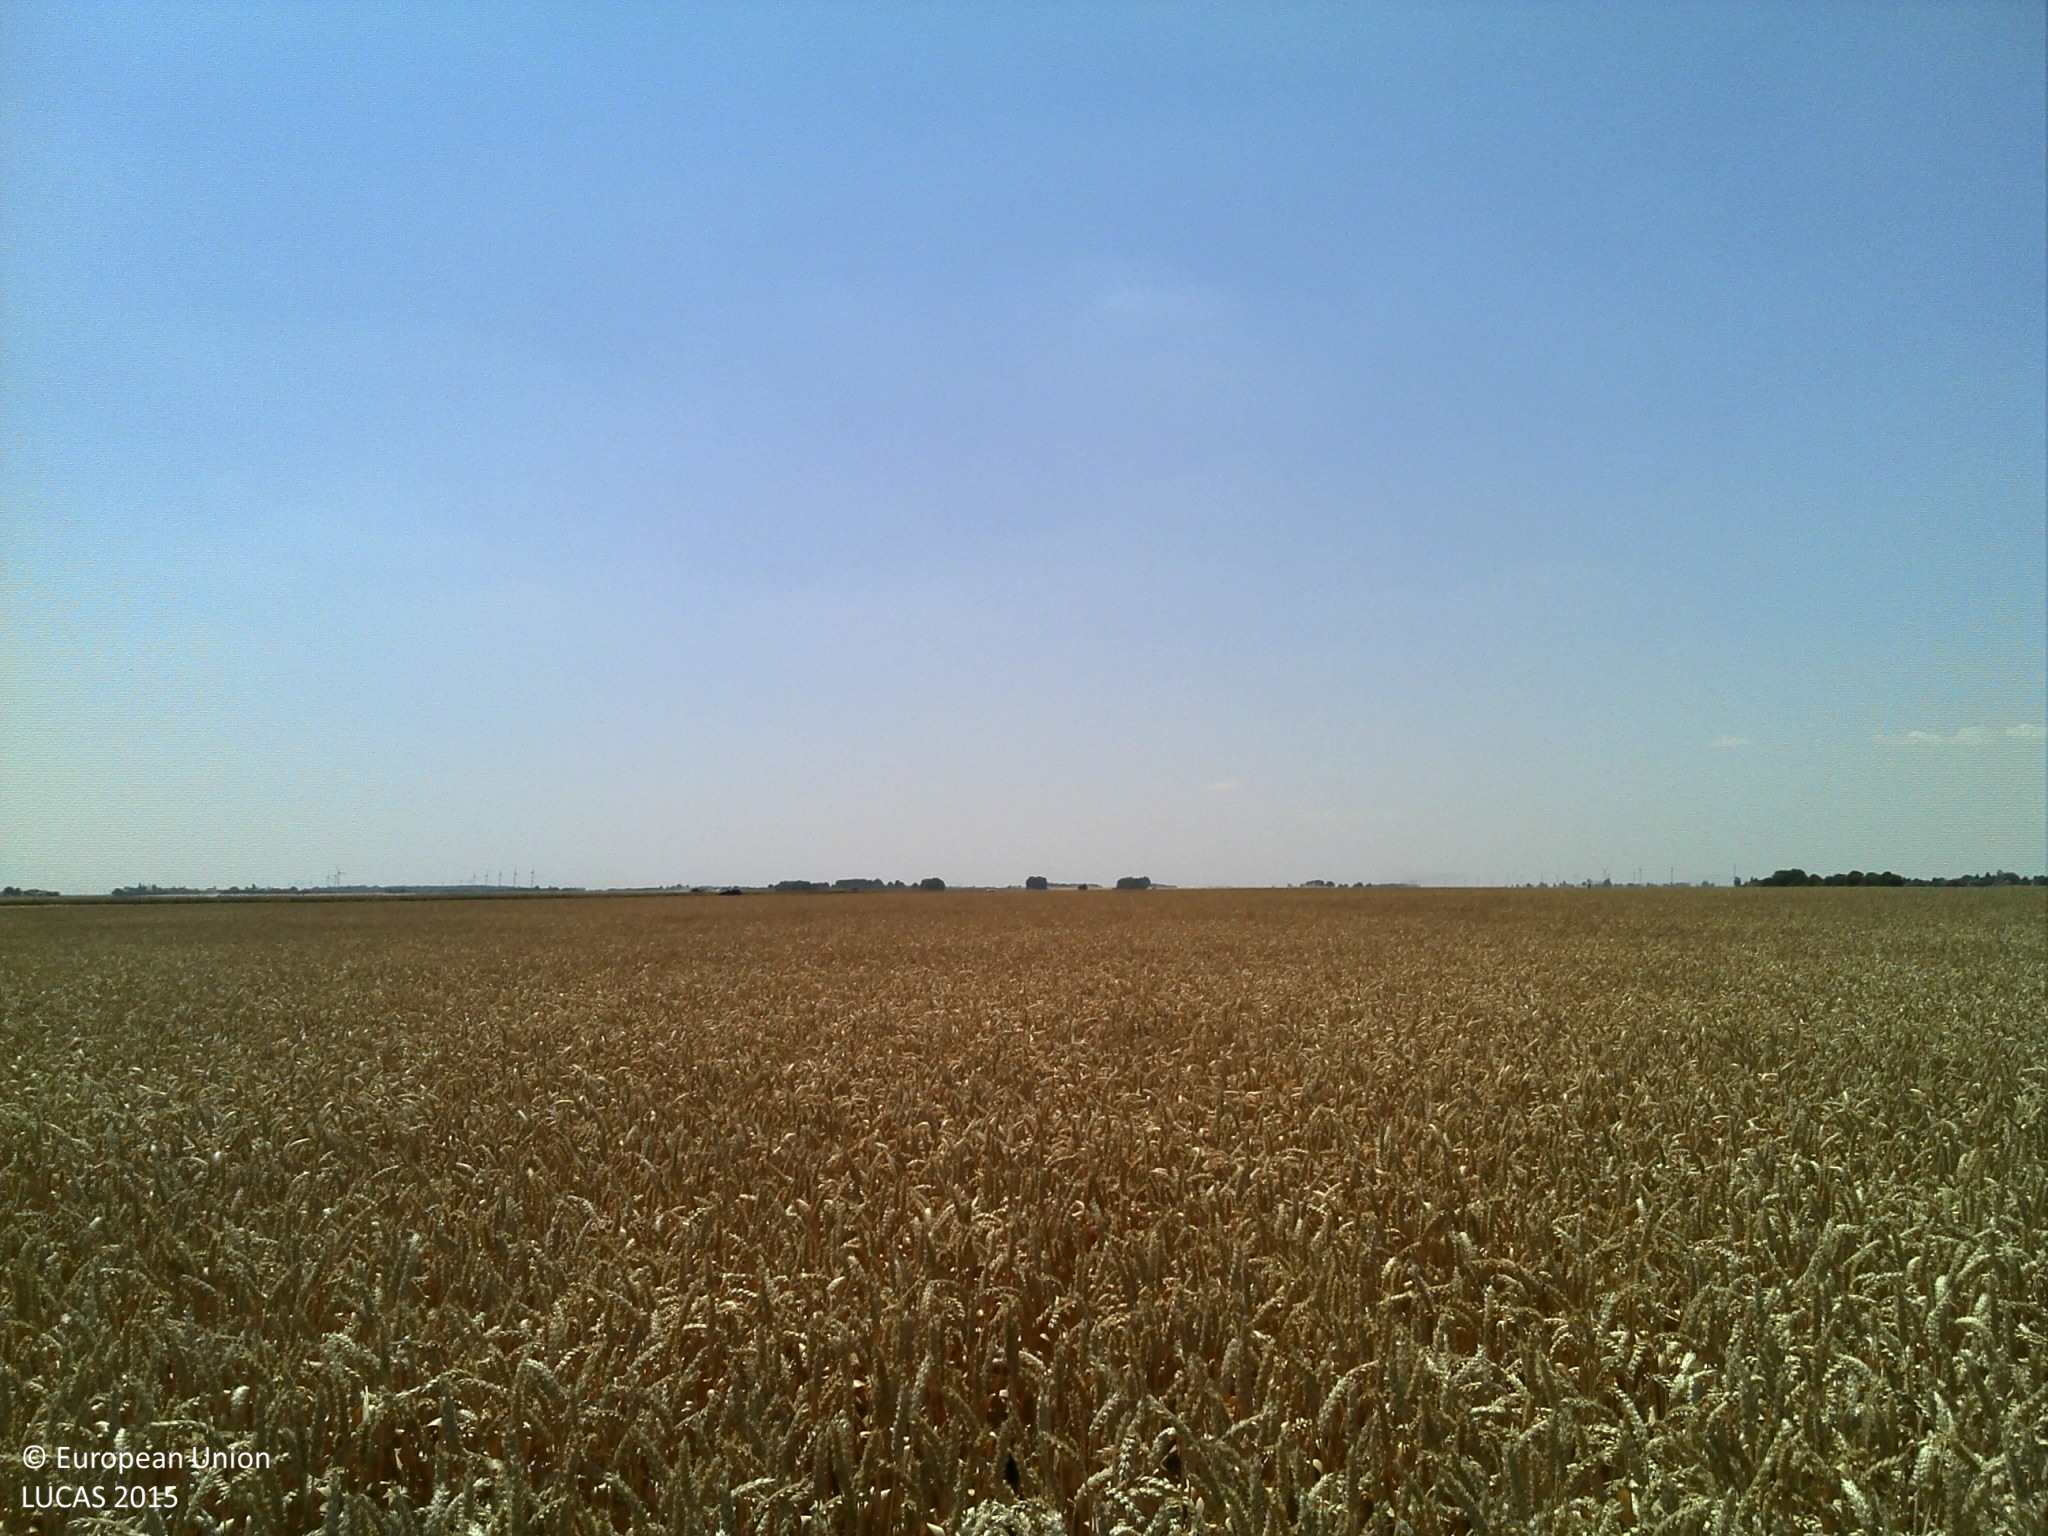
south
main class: Cropland
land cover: Common wheat
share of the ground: > 75 %
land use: Agriculture (excluding fallow land and kitchen gardens)
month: July
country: FR
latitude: 48.4526
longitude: 1.9412
